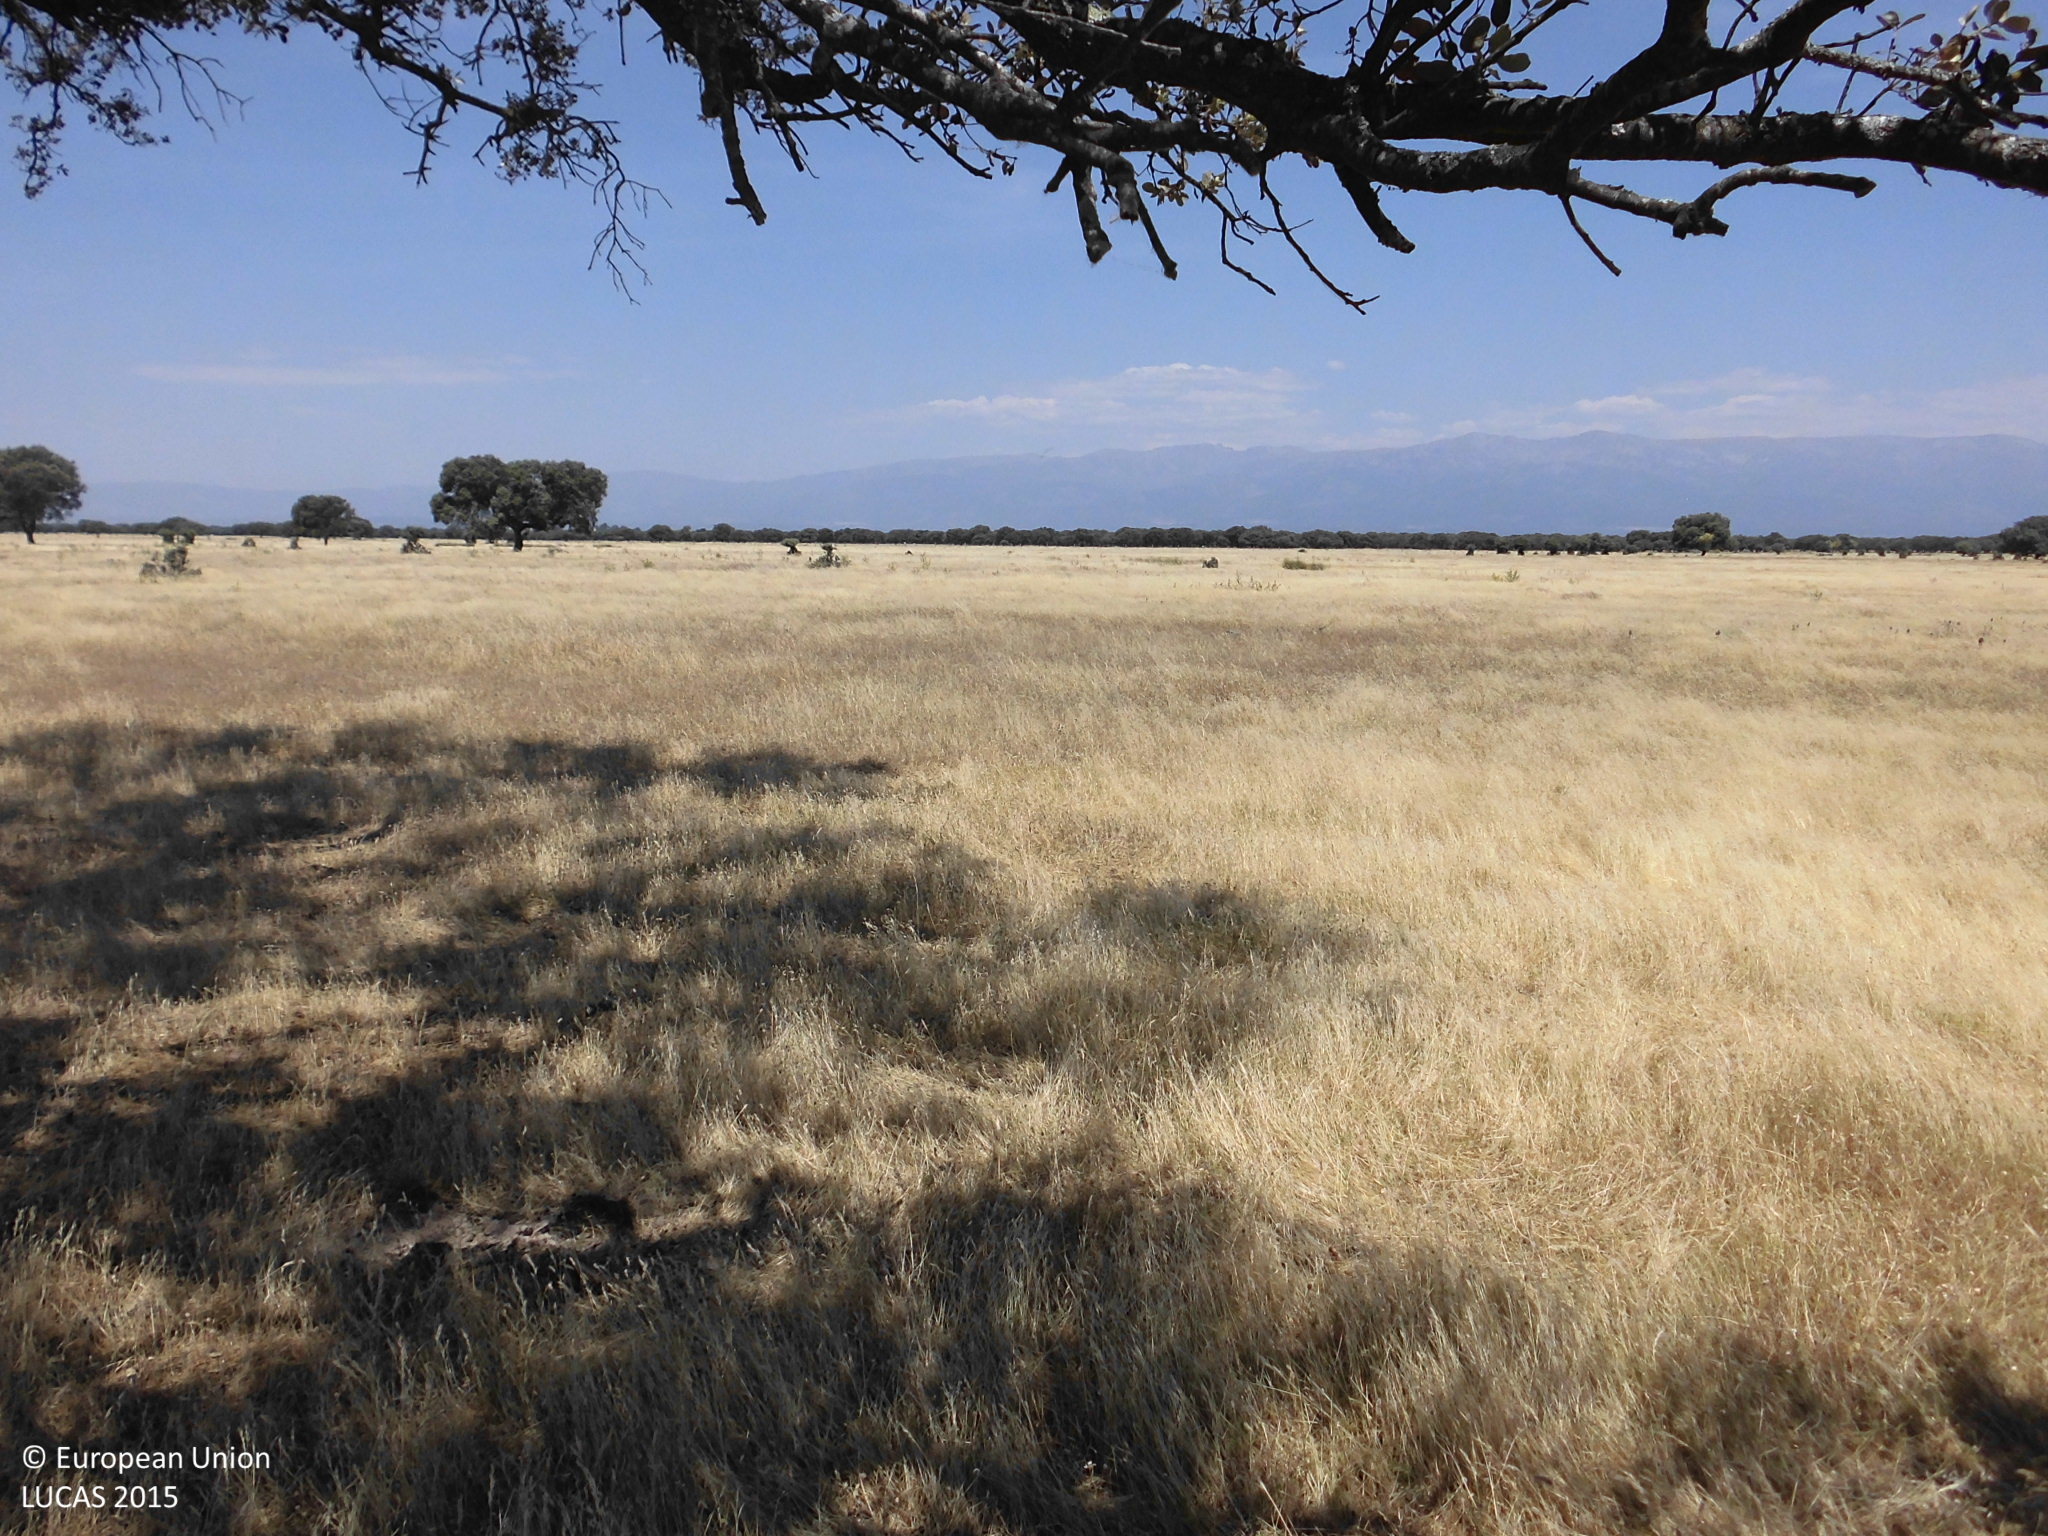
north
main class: Woodland
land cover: Broadleaved woodland
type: broadleaved evergreen forest
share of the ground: 10 - 25 %
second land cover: Grassland without tree/shrub cover
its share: > 75 %
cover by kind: herbaceous plants 90 %, broadleaved forest trees 10 %
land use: Forestry
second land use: Agriculture (excluding fallow land and kitchen gardens)
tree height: > 5 m
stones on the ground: < 10 %
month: June
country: ES
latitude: 39.9437
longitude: -5.4007
